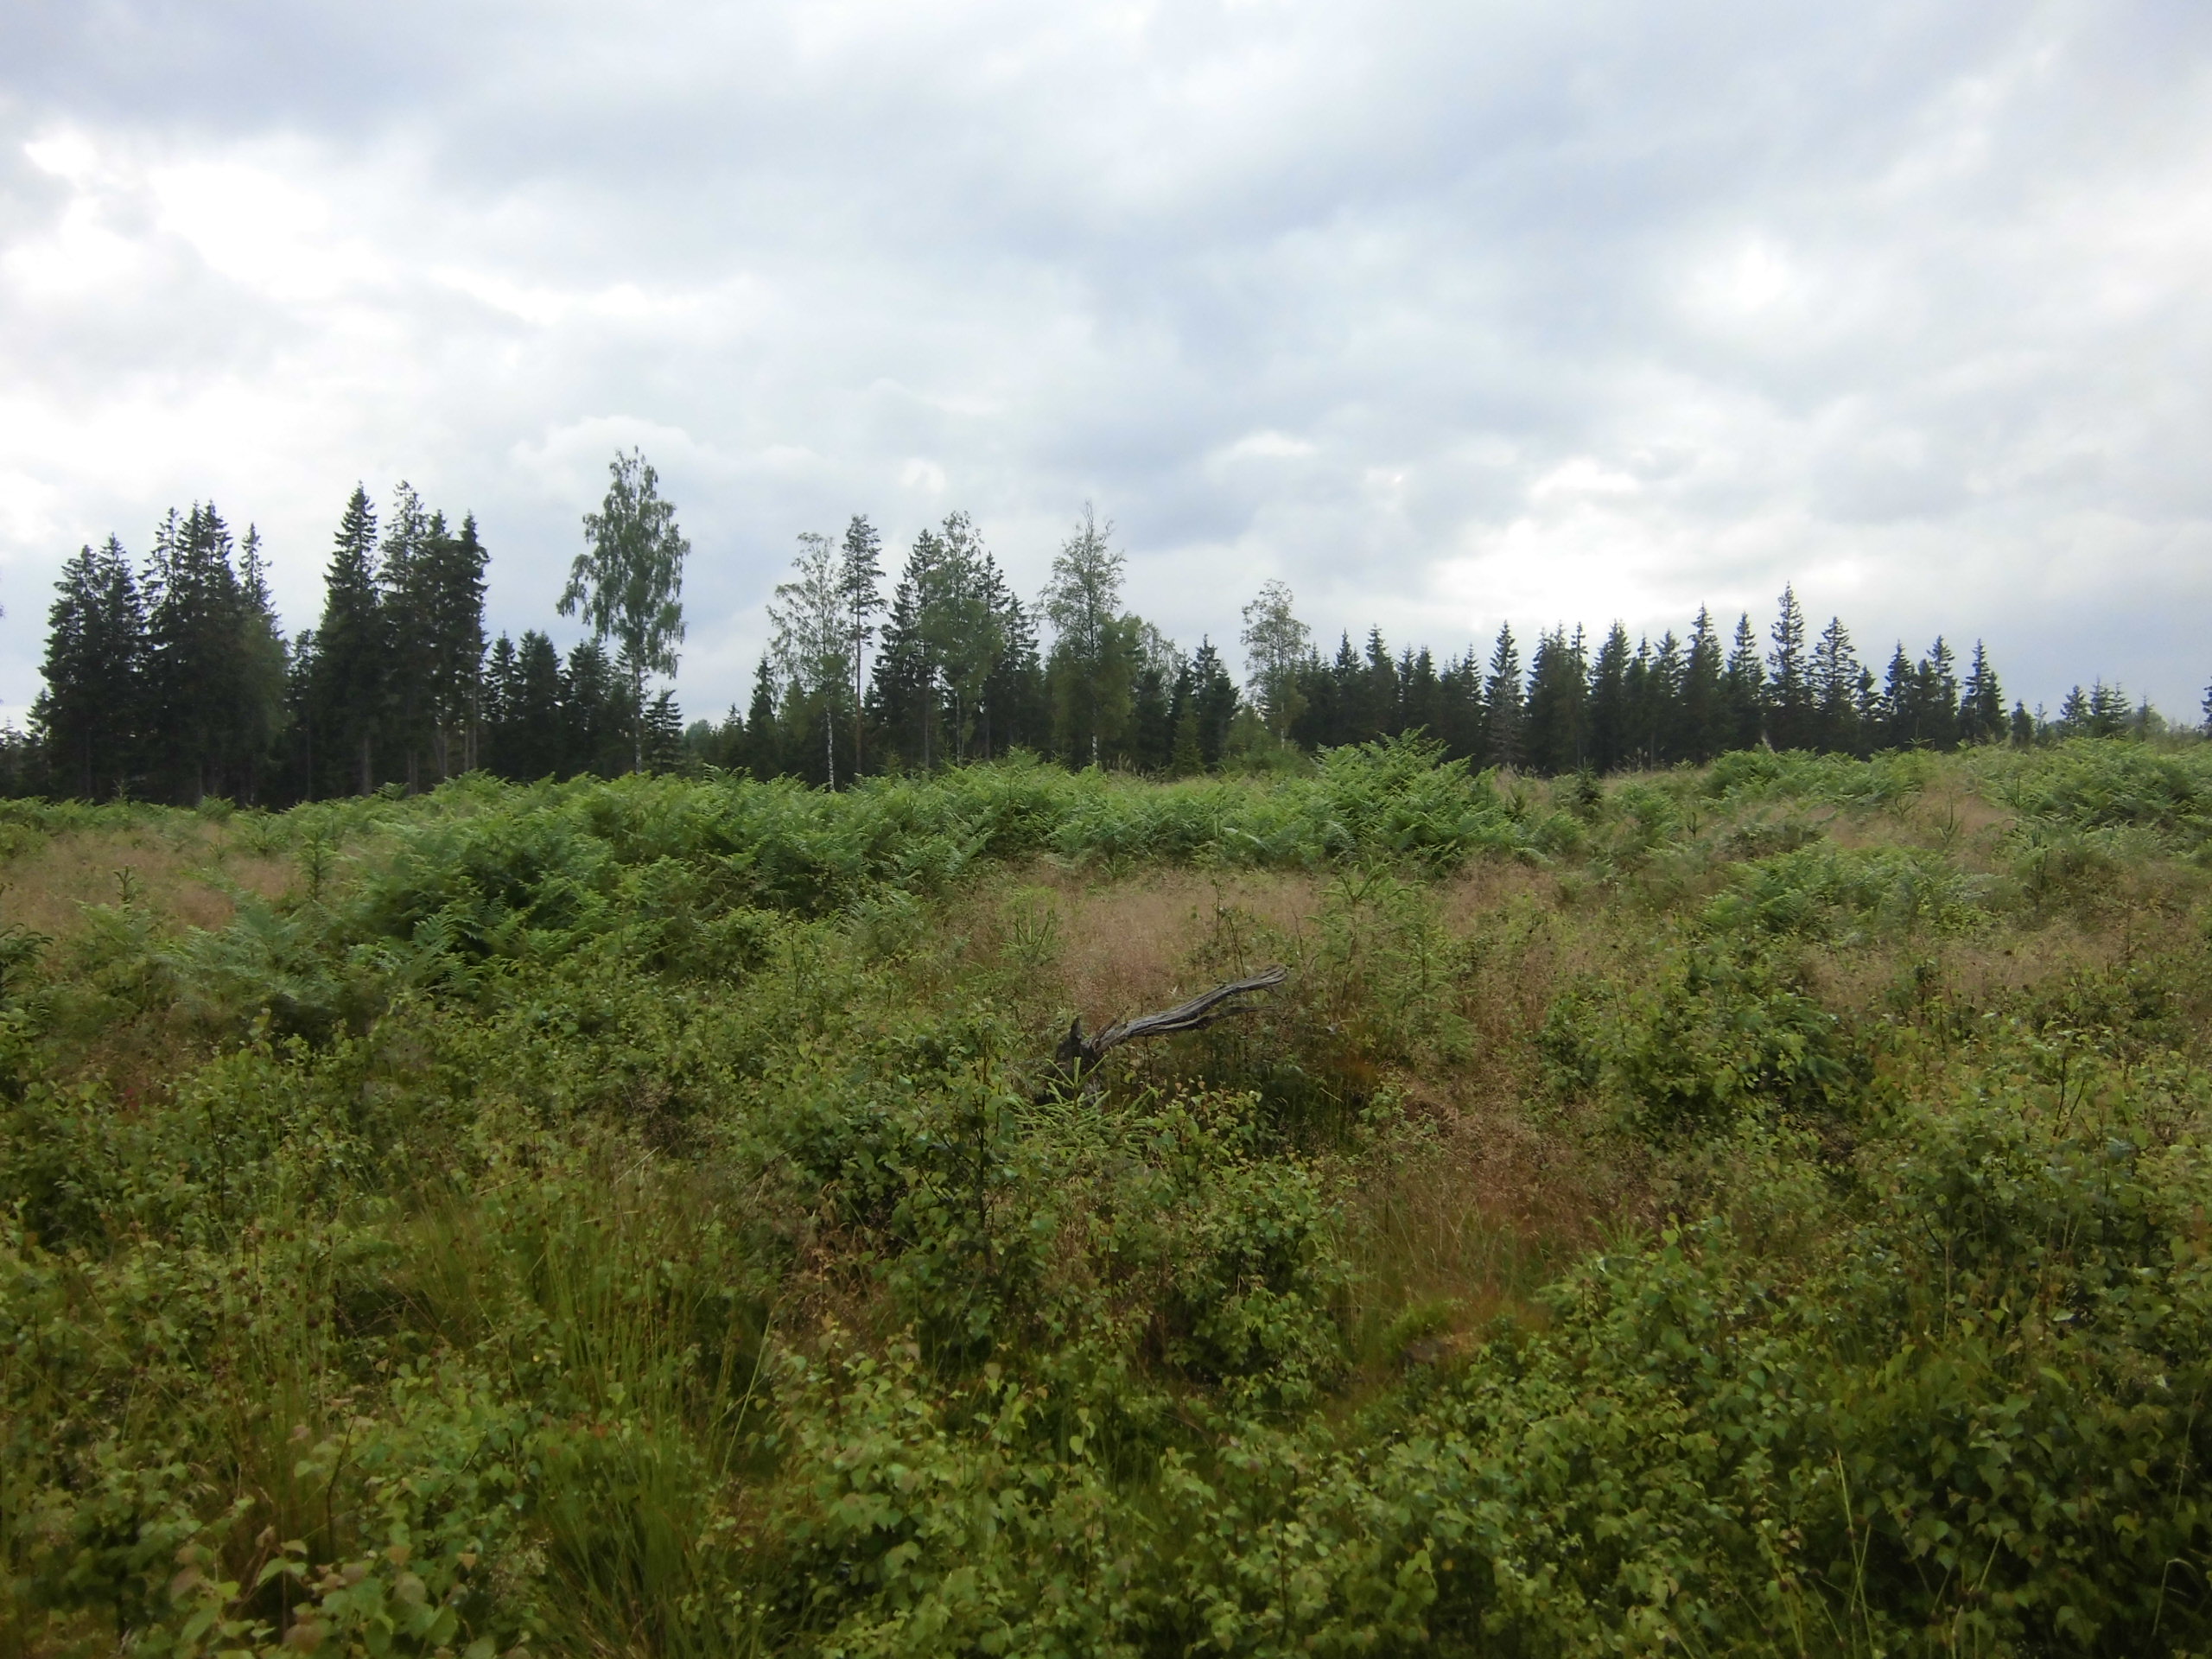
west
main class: Woodland
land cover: Spruce dominated mixed woodland
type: boreal forest
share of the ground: 50 - 75 %
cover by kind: broadleaved forest trees 35 %, coniferous forest trees 25 %, shrubs 20 %, herbaceous plants 20 %
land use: Forestry
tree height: < 5 m
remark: Clear cut
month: July
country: SE
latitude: 57.2556
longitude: 15.1521
